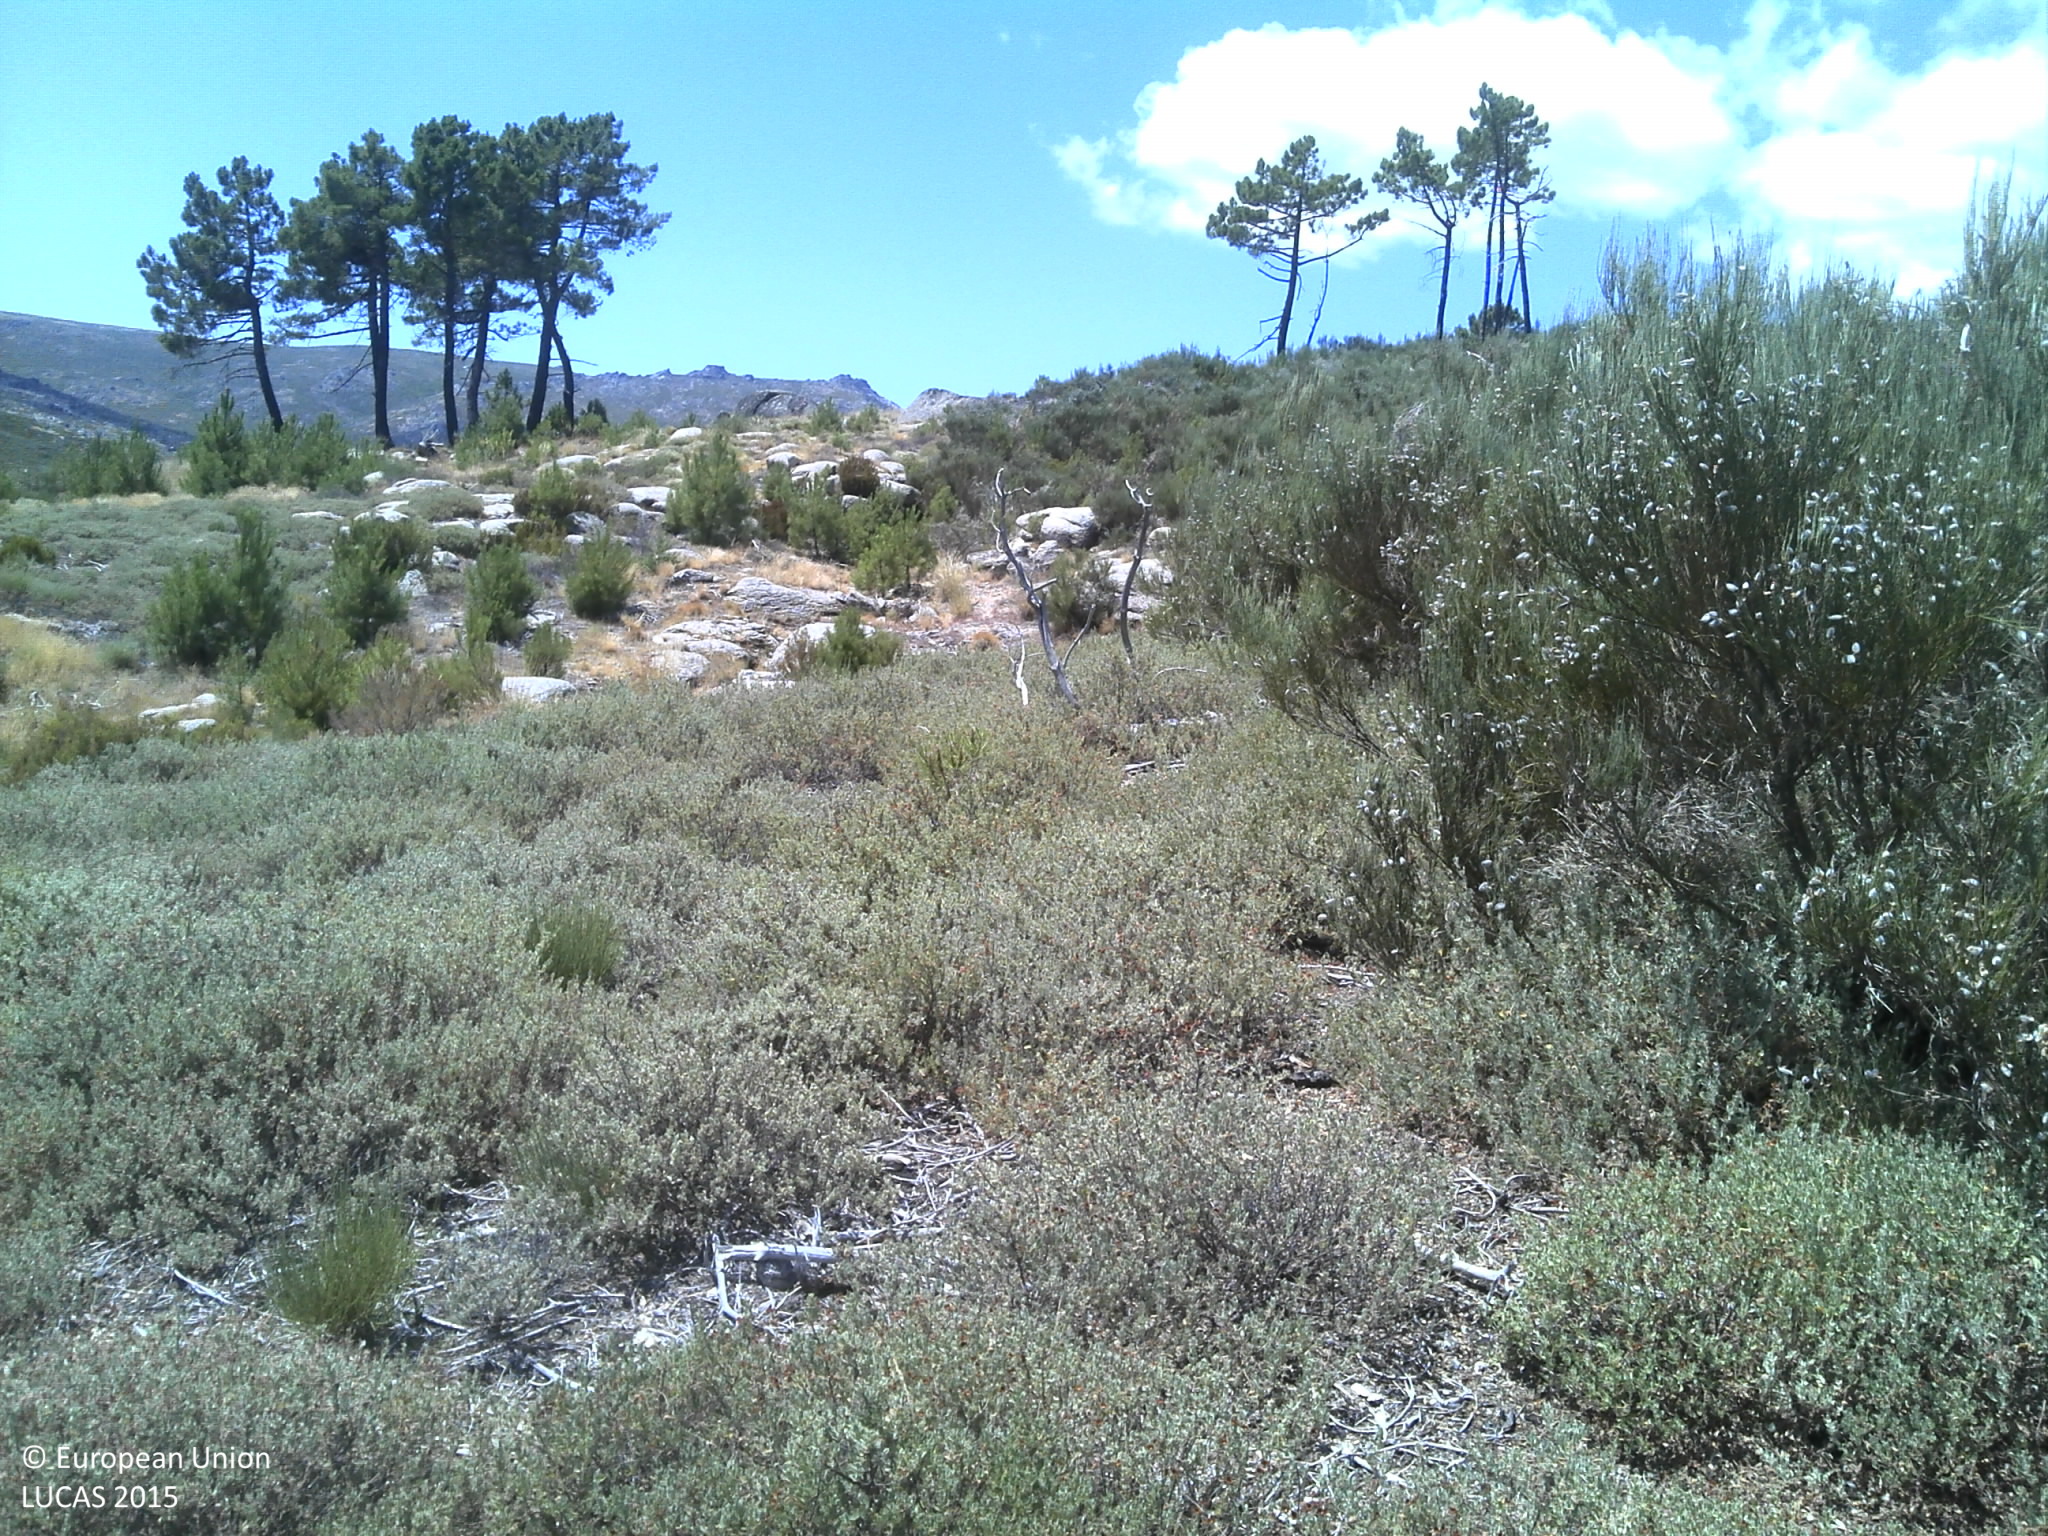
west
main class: Shrubland
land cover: Shrubland without tree cover
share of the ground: > 75 %
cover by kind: shrubs 75 %, consolidated bare surface 20 %, herbaceous plants 5 %
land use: Semi-natural and natural areas not in use
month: July
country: PT
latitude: 40.3559
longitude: -7.5238
